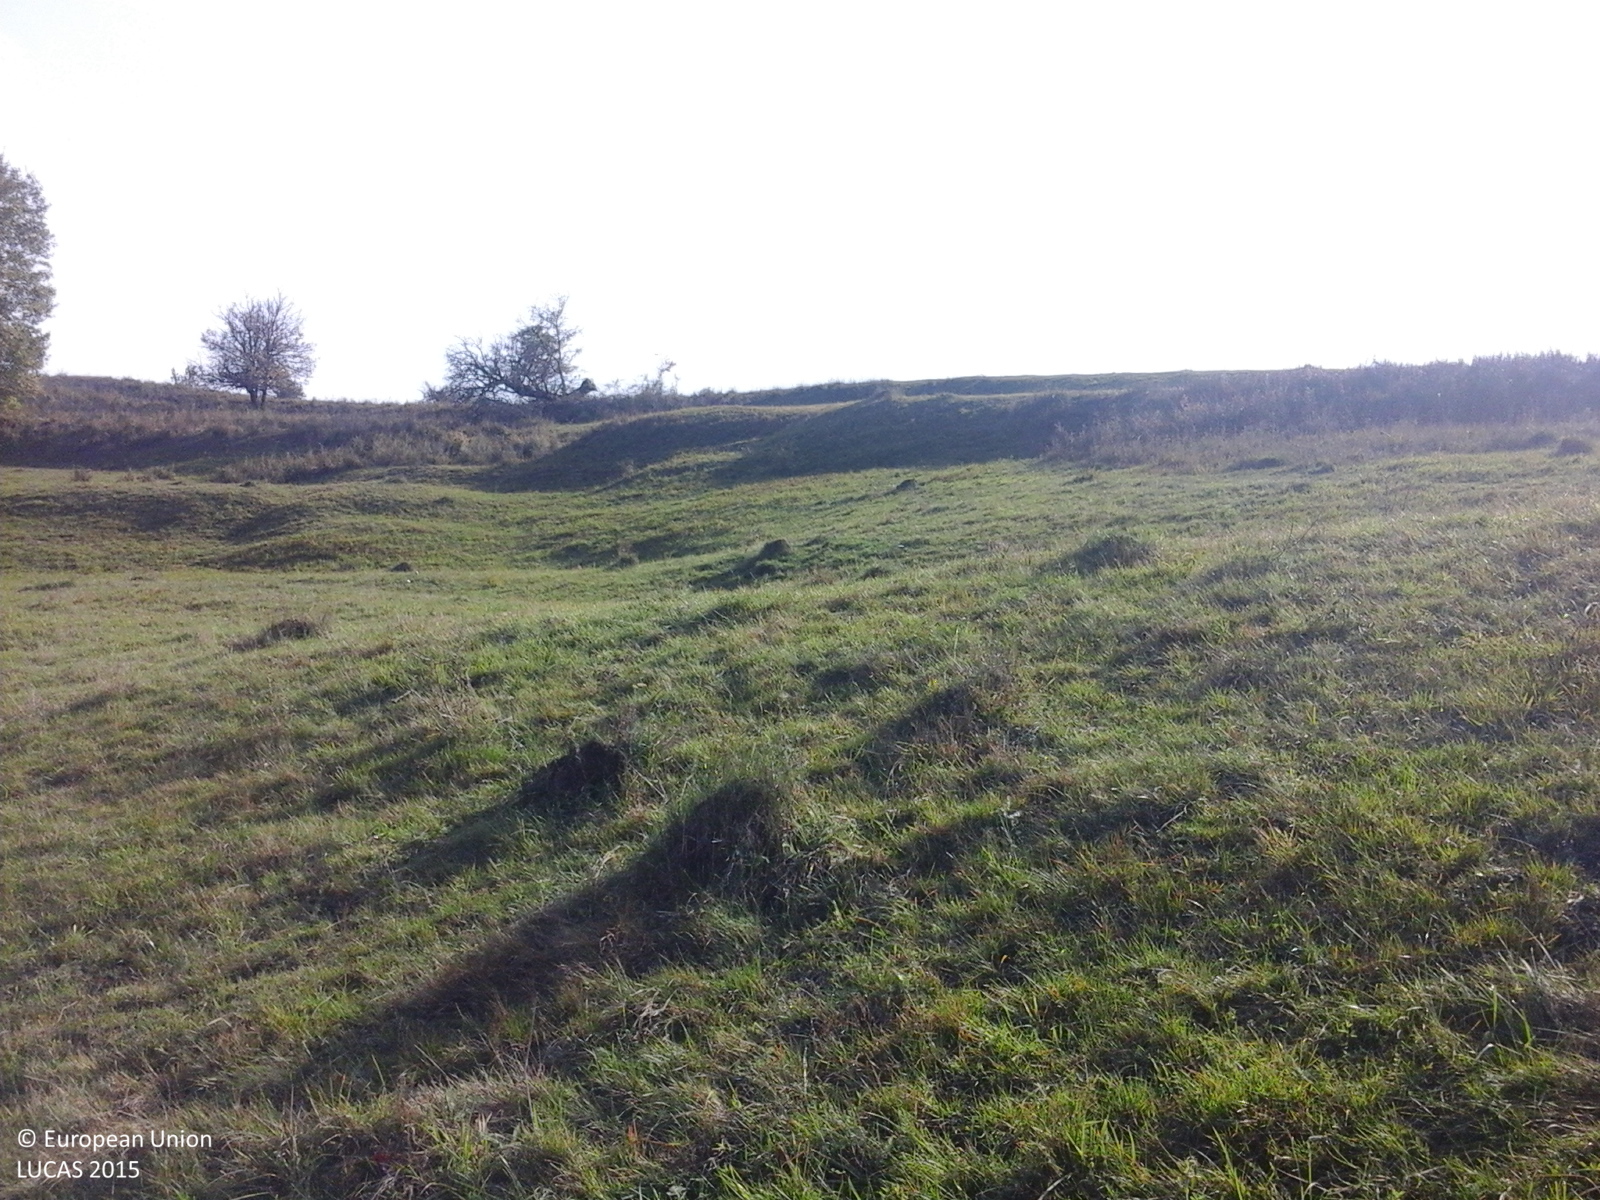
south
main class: Grassland
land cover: Grassland without tree/shrub cover
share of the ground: > 75 %
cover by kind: herbaceous plants 100 %
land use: Agriculture (excluding fallow land and kitchen gardens)
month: October
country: RO
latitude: 45.9497
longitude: 24.9672
